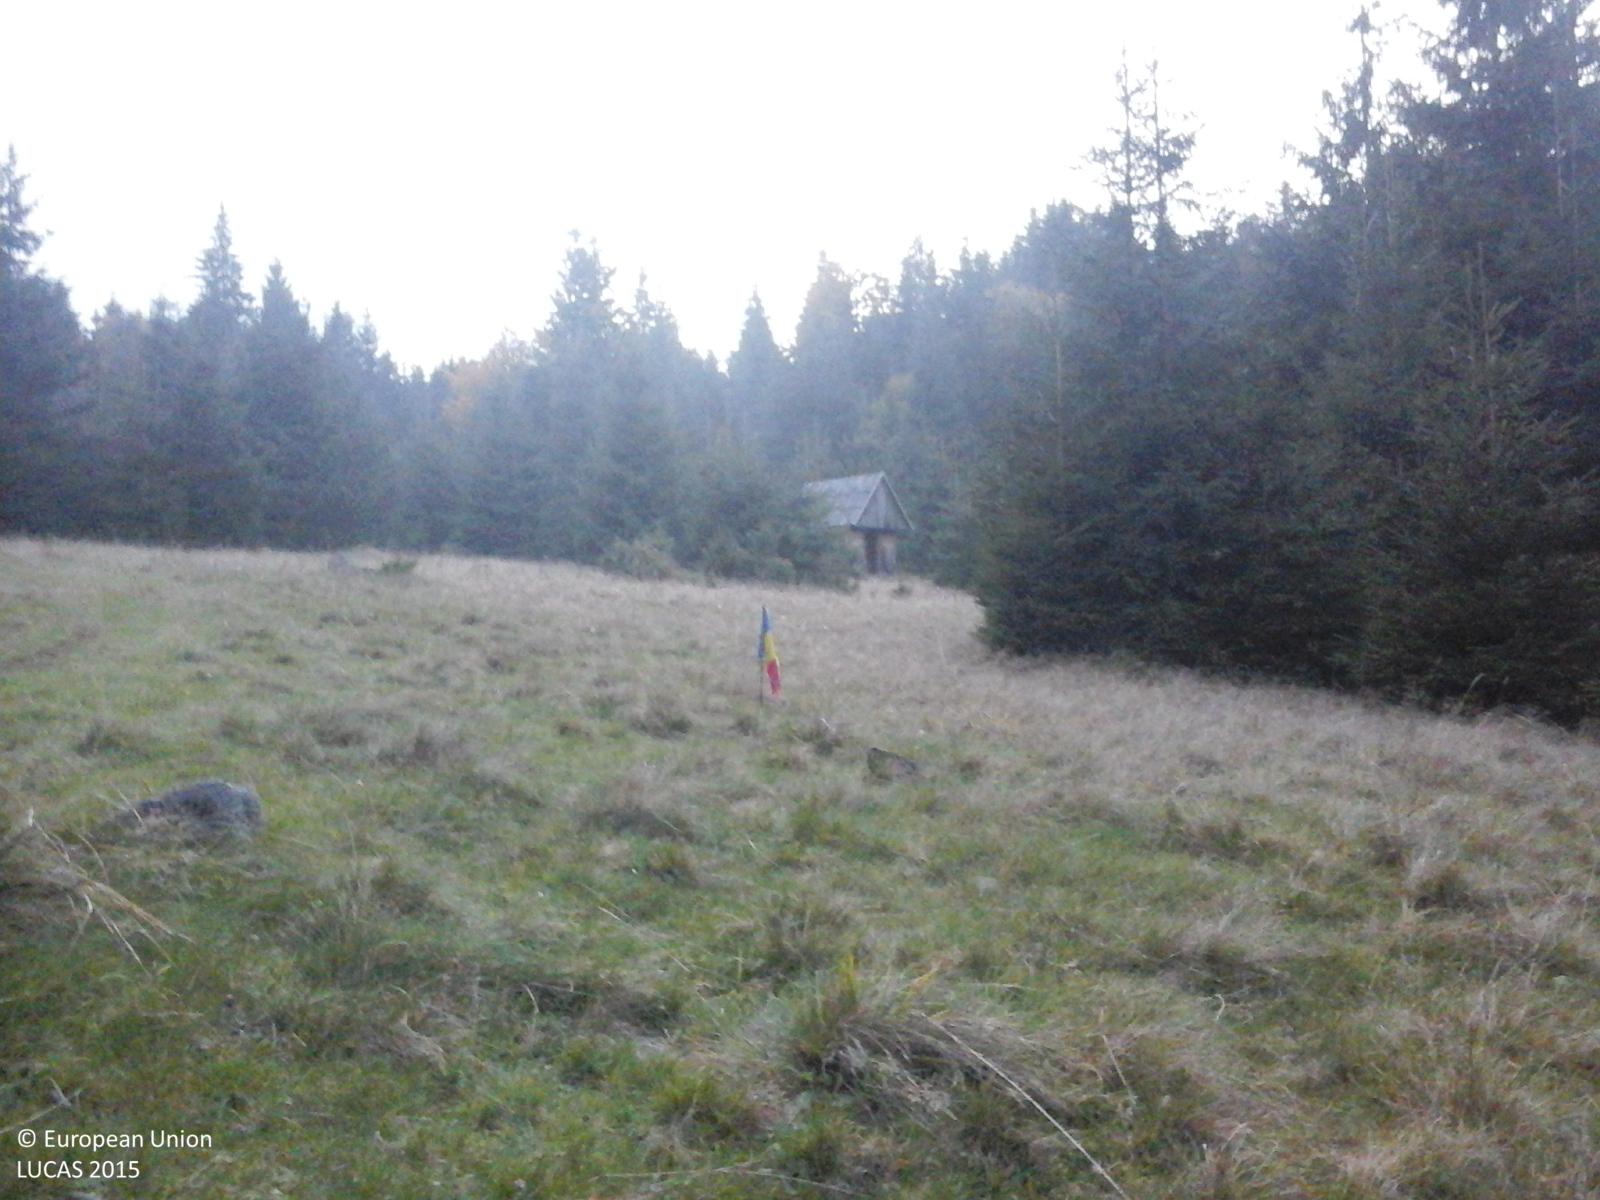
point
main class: Grassland
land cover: Spontaneously vegetated surfaces
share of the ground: > 75 %
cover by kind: herbaceous plants 100 %
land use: Fallow land
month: October
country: RO
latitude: 46.6377
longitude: 25.4047
